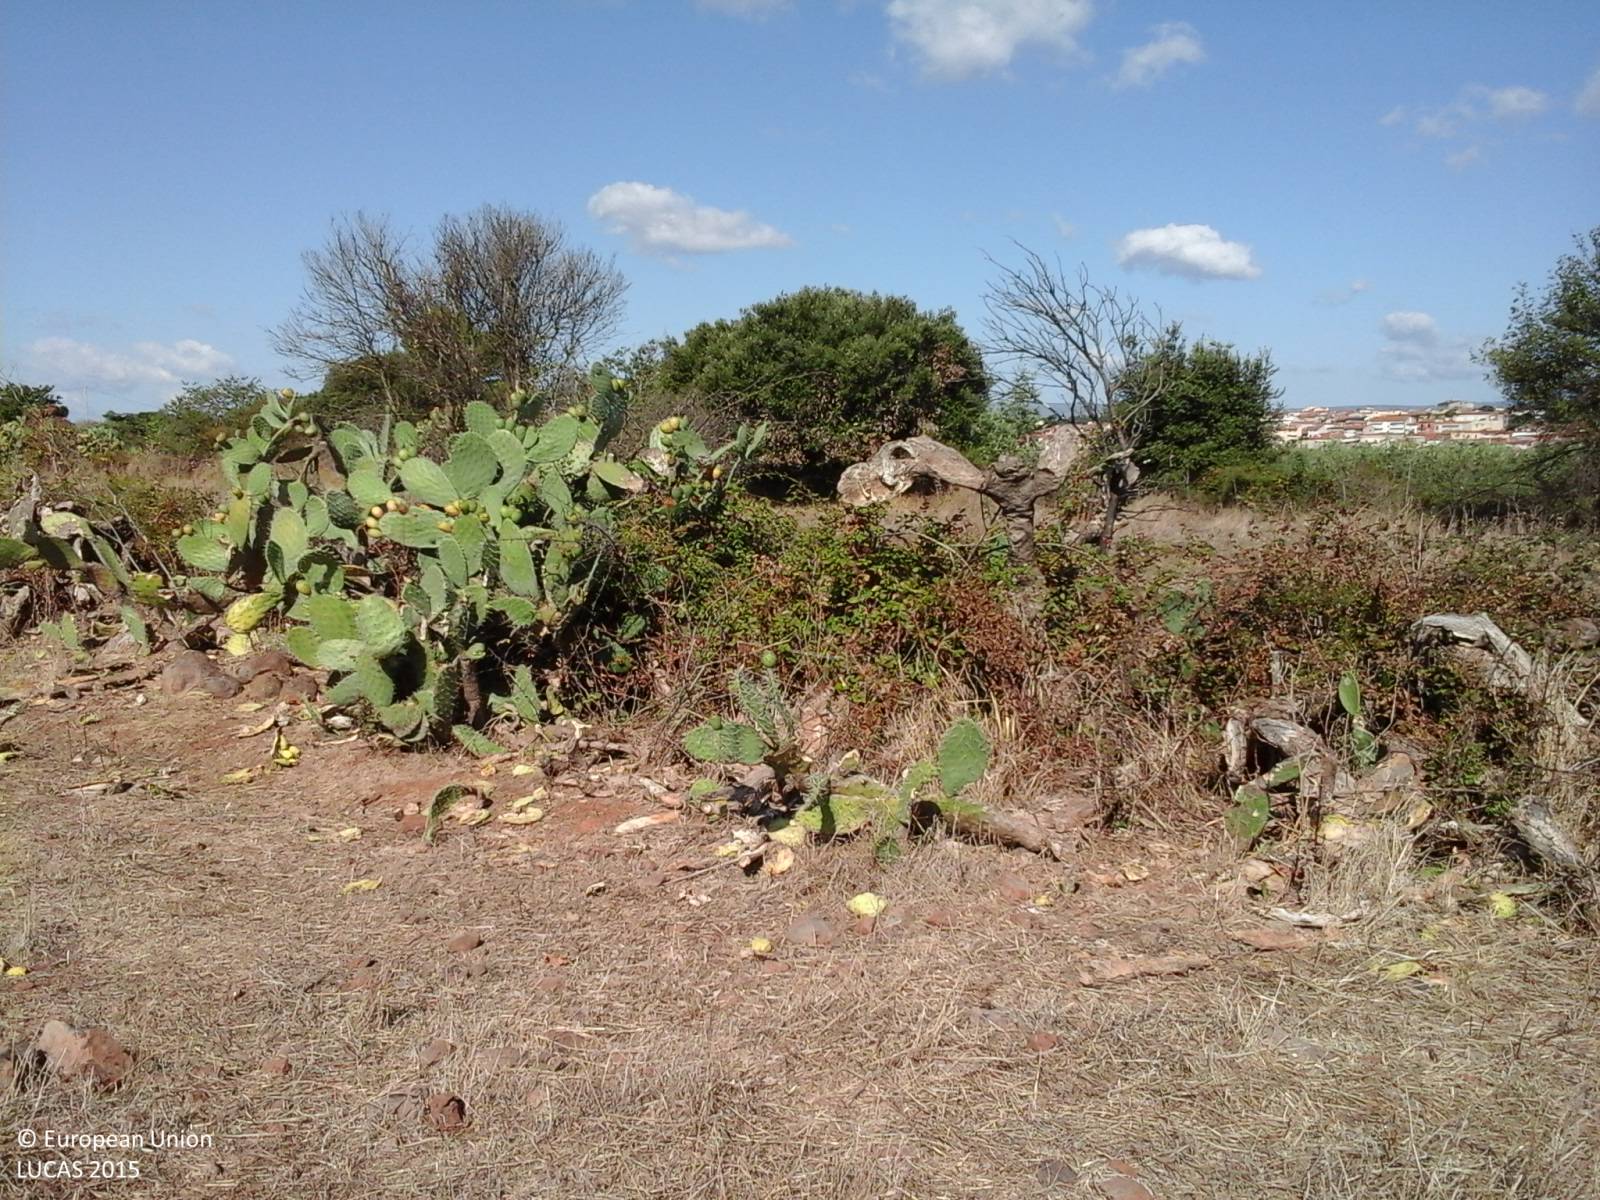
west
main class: Grassland
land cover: Grassland without tree/shrub cover
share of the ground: 25 - 50 %
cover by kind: herbaceous plants 100 %
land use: Agriculture (excluding fallow land and kitchen gardens)
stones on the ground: 25 - 50 %
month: August
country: IT
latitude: 40.1157
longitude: 8.8446
